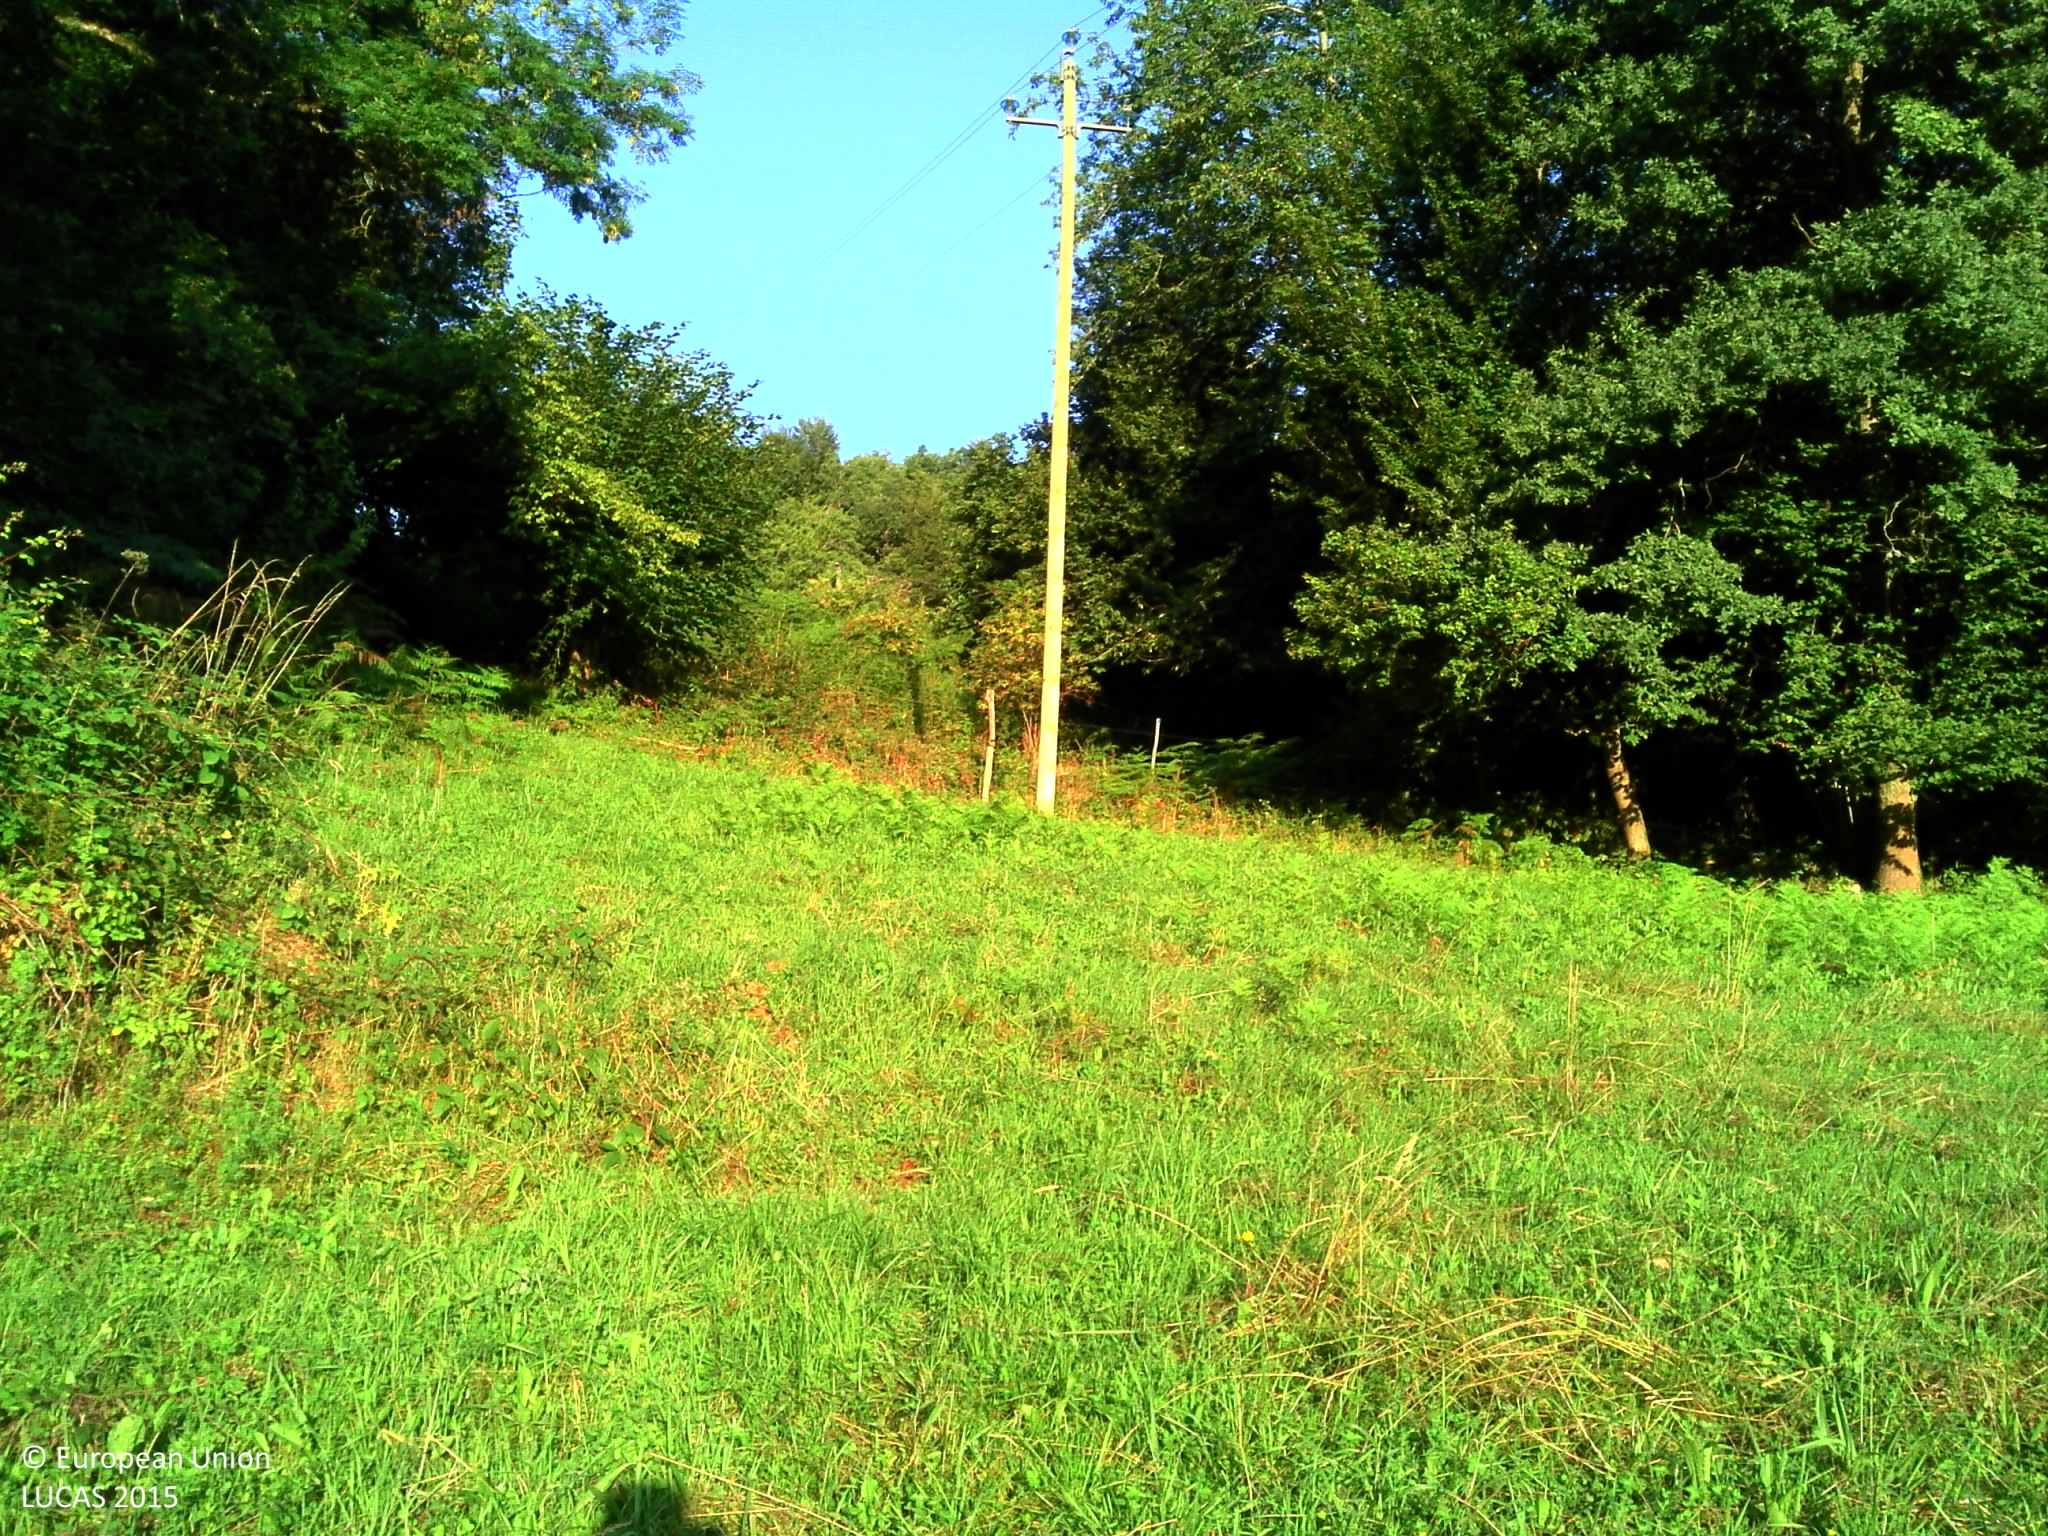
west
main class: Grassland
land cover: Grassland without tree/shrub cover
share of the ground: > 75 %
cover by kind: herbaceous plants 100 %
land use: Agriculture (excluding fallow land and kitchen gardens)
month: August
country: FR
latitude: 42.9823
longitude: 1.4587
